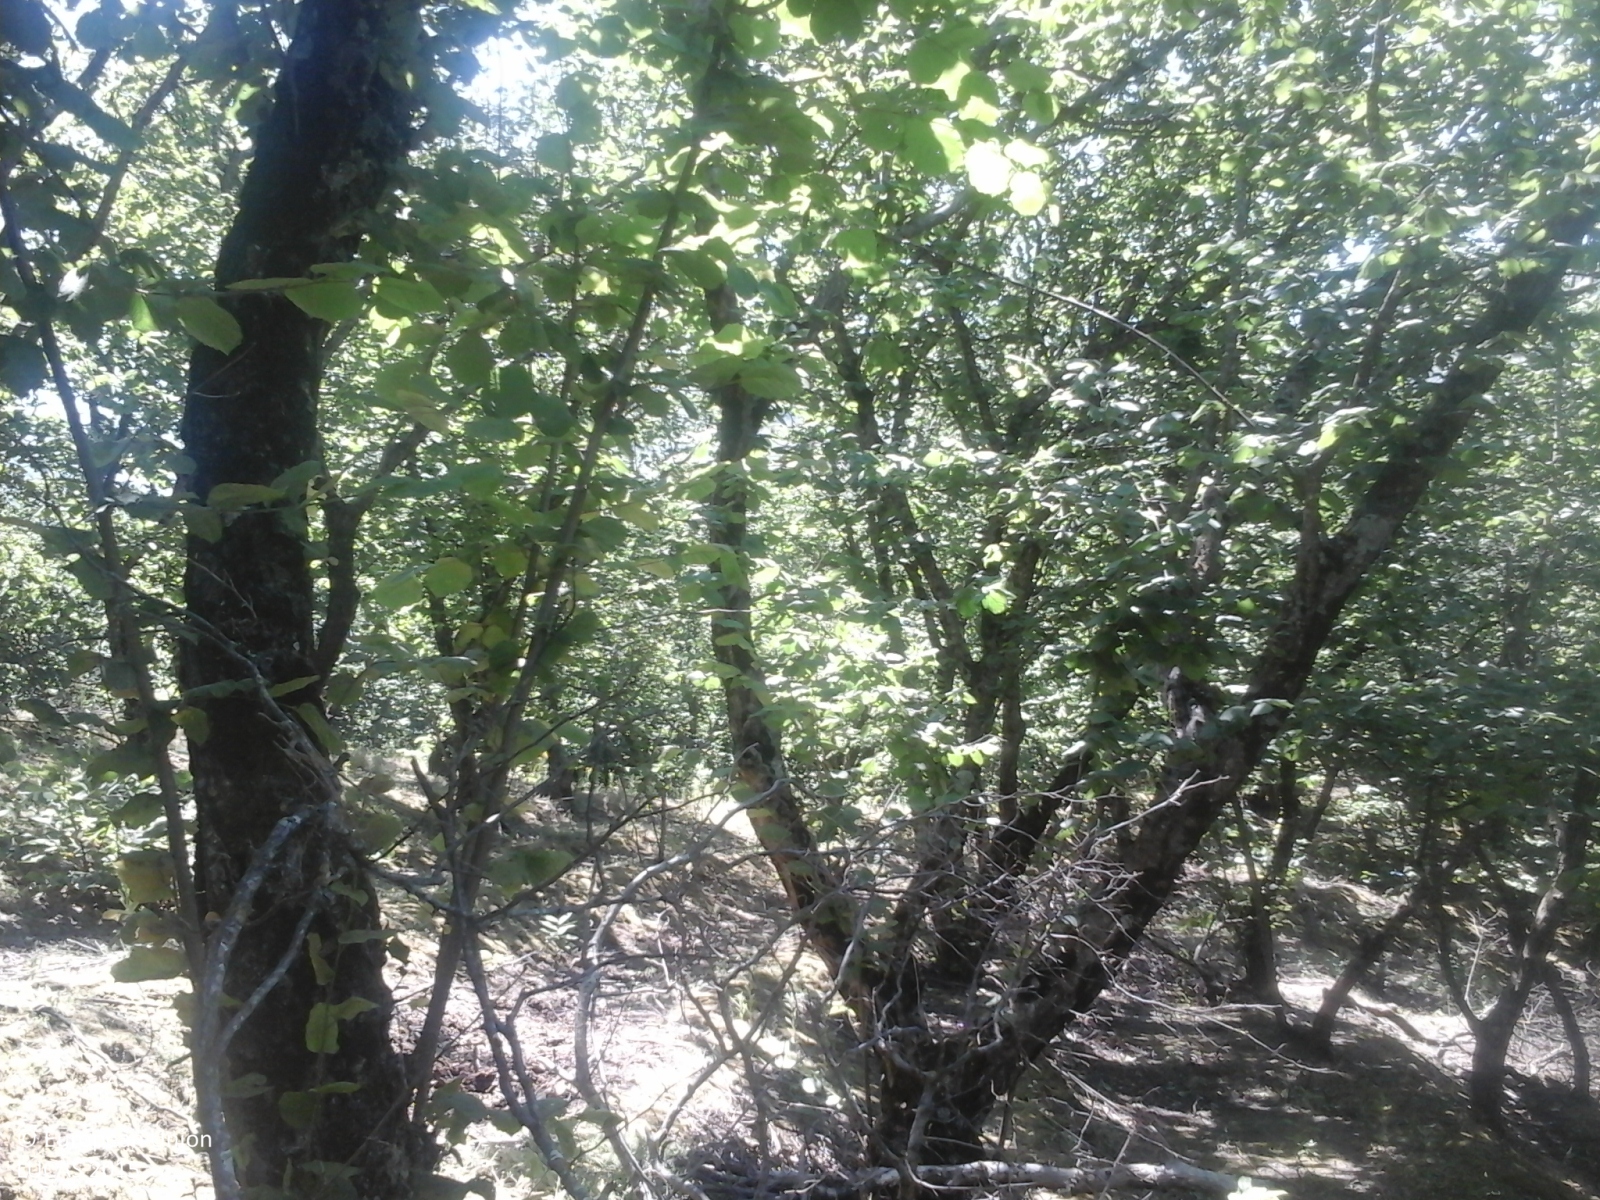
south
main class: Cropland
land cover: Nuts trees
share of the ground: > 75 %
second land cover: Spontaneously vegetated surfaces
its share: > 75 %
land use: Agriculture (excluding fallow land and kitchen gardens)
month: July
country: IT
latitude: 40.8991
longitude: 14.6700
